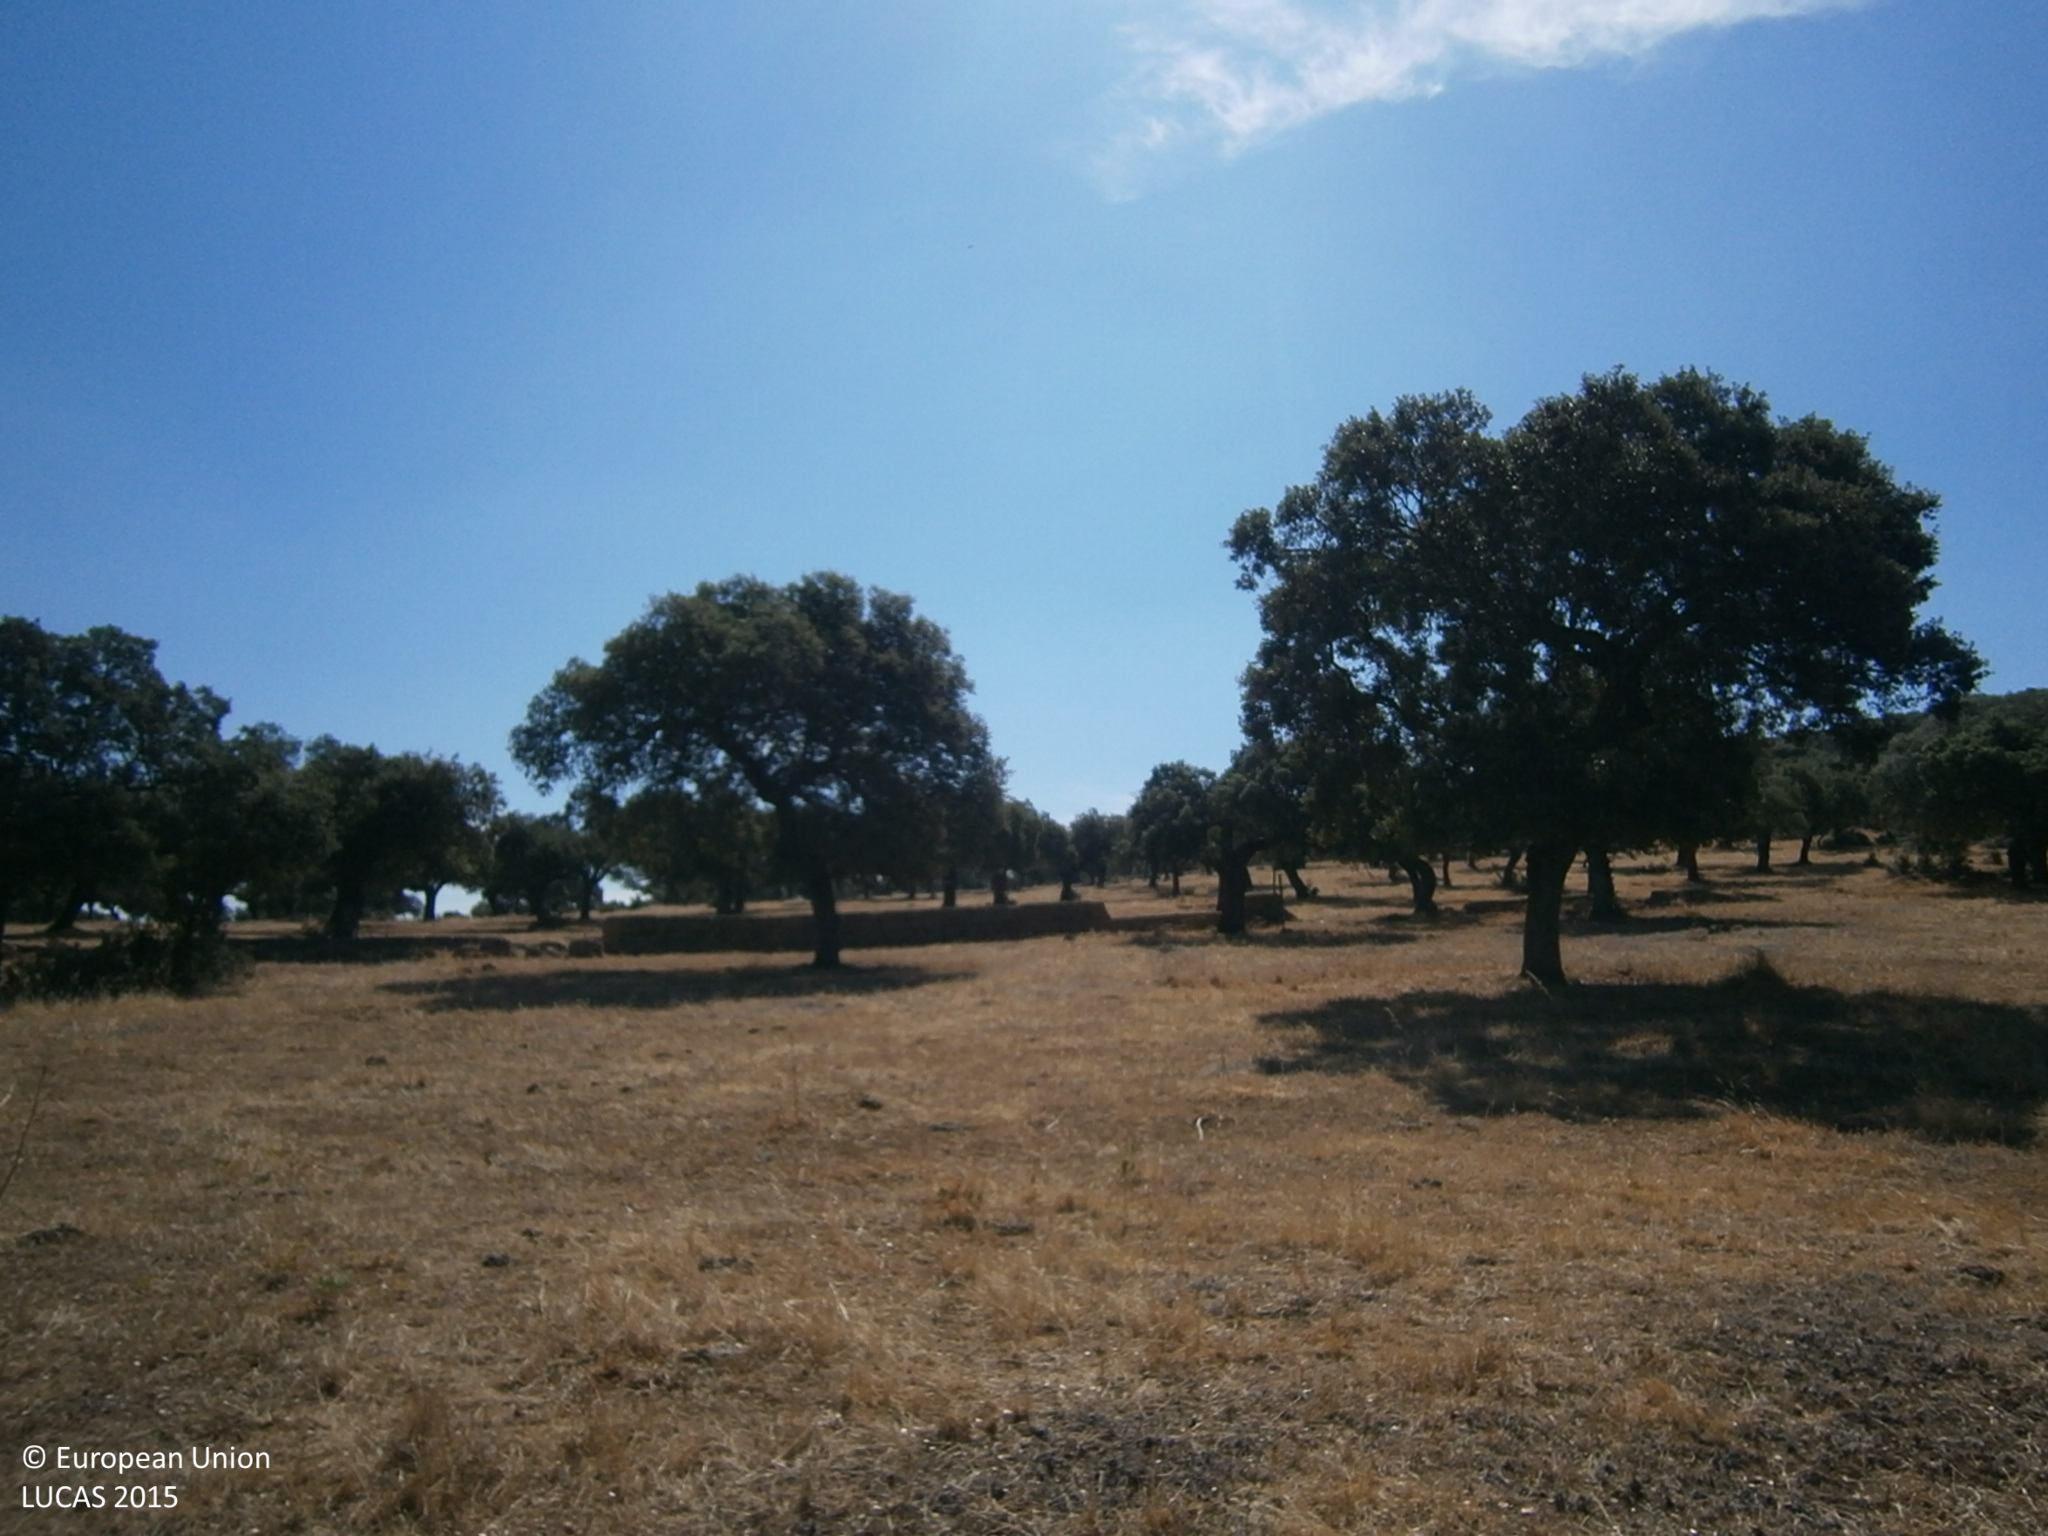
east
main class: Woodland
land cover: Broadleaved woodland
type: broadleaved evergreen forest
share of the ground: 50 - 75 %
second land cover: Spontaneously vegetated surfaces
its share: 25 - 50 %
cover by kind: broadleaved forest trees 50 %, herbaceous plants 45 %, shrubs 5 %
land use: Forestry
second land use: Agriculture (excluding fallow land and kitchen gardens)
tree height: > 5 m
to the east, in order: Broadleaved woodland; Spontaneously vegetated surfaces; Dry stone walls; Broadleaved woodland
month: June
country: ES
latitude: 38.6874
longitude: -6.9540
